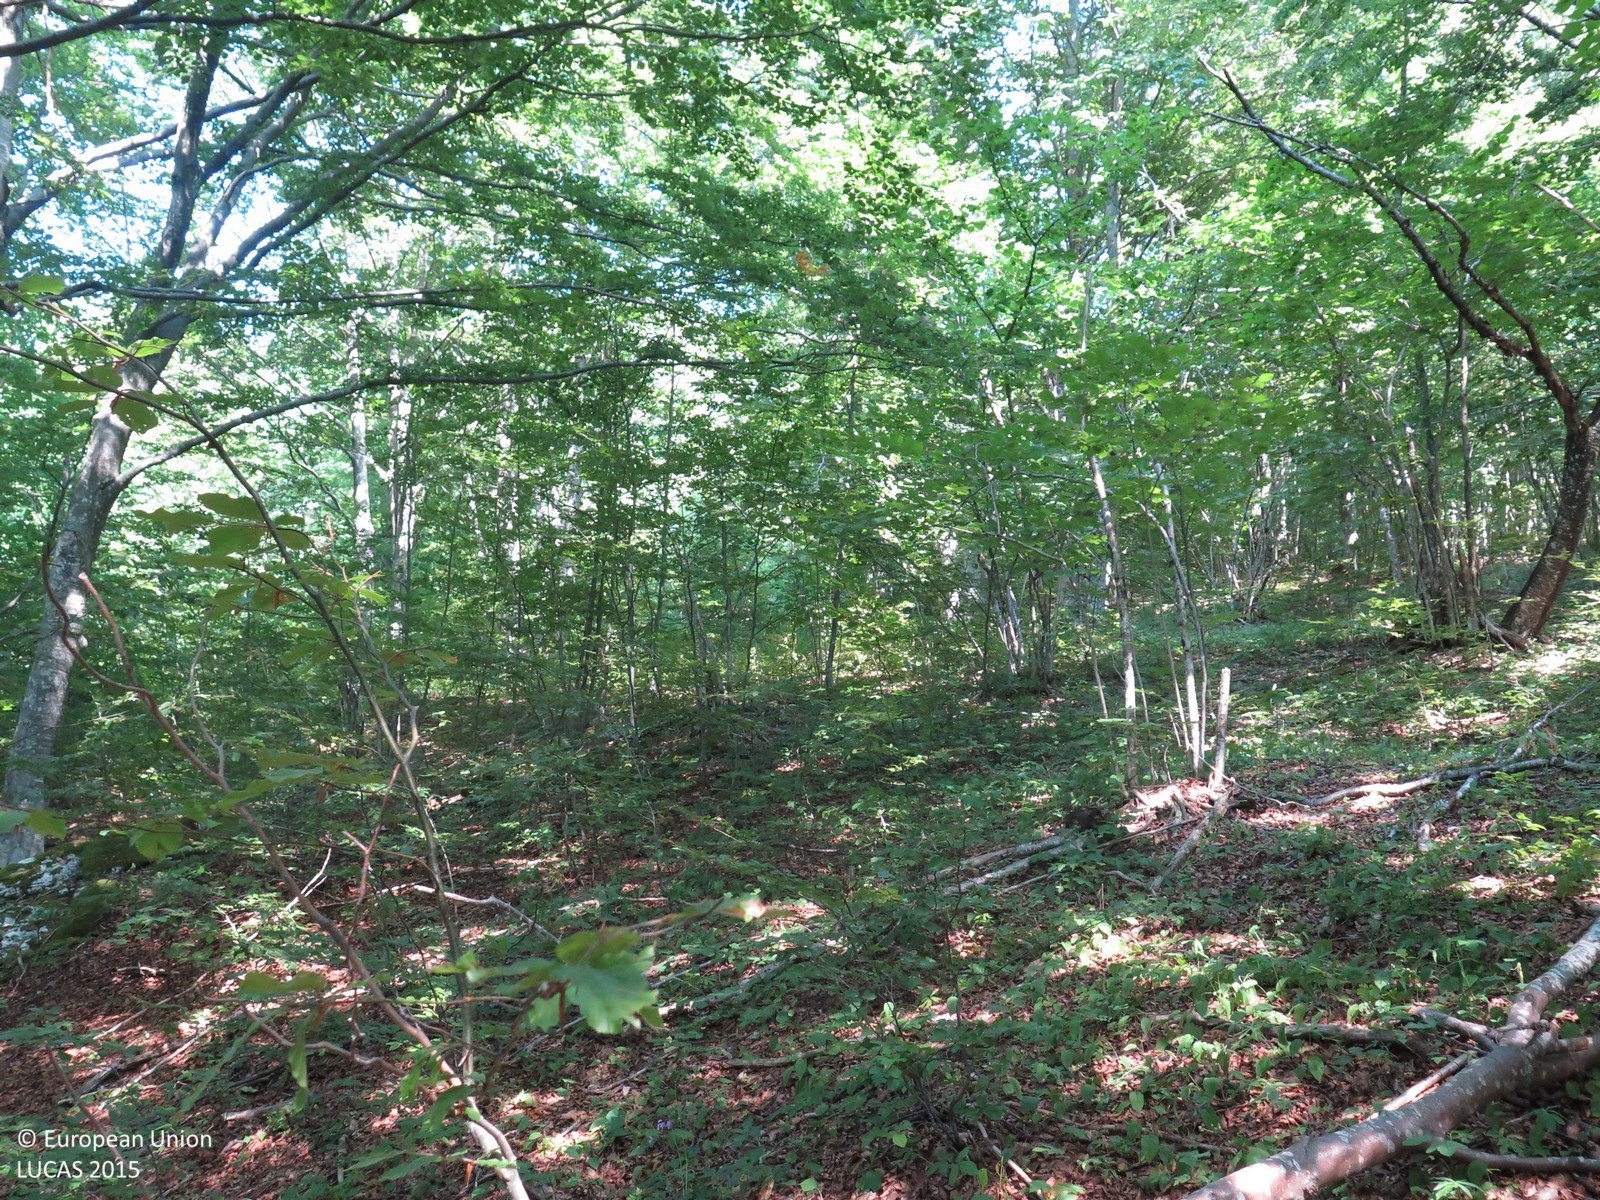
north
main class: Woodland
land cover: Broadleaved woodland
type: beech forest
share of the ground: > 75 %
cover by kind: broadleaved forest trees 95 %, unconsolidated bare surface 5 %
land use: Forestry
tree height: > 5 m
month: August
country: HR
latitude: 45.3745
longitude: 14.8604
